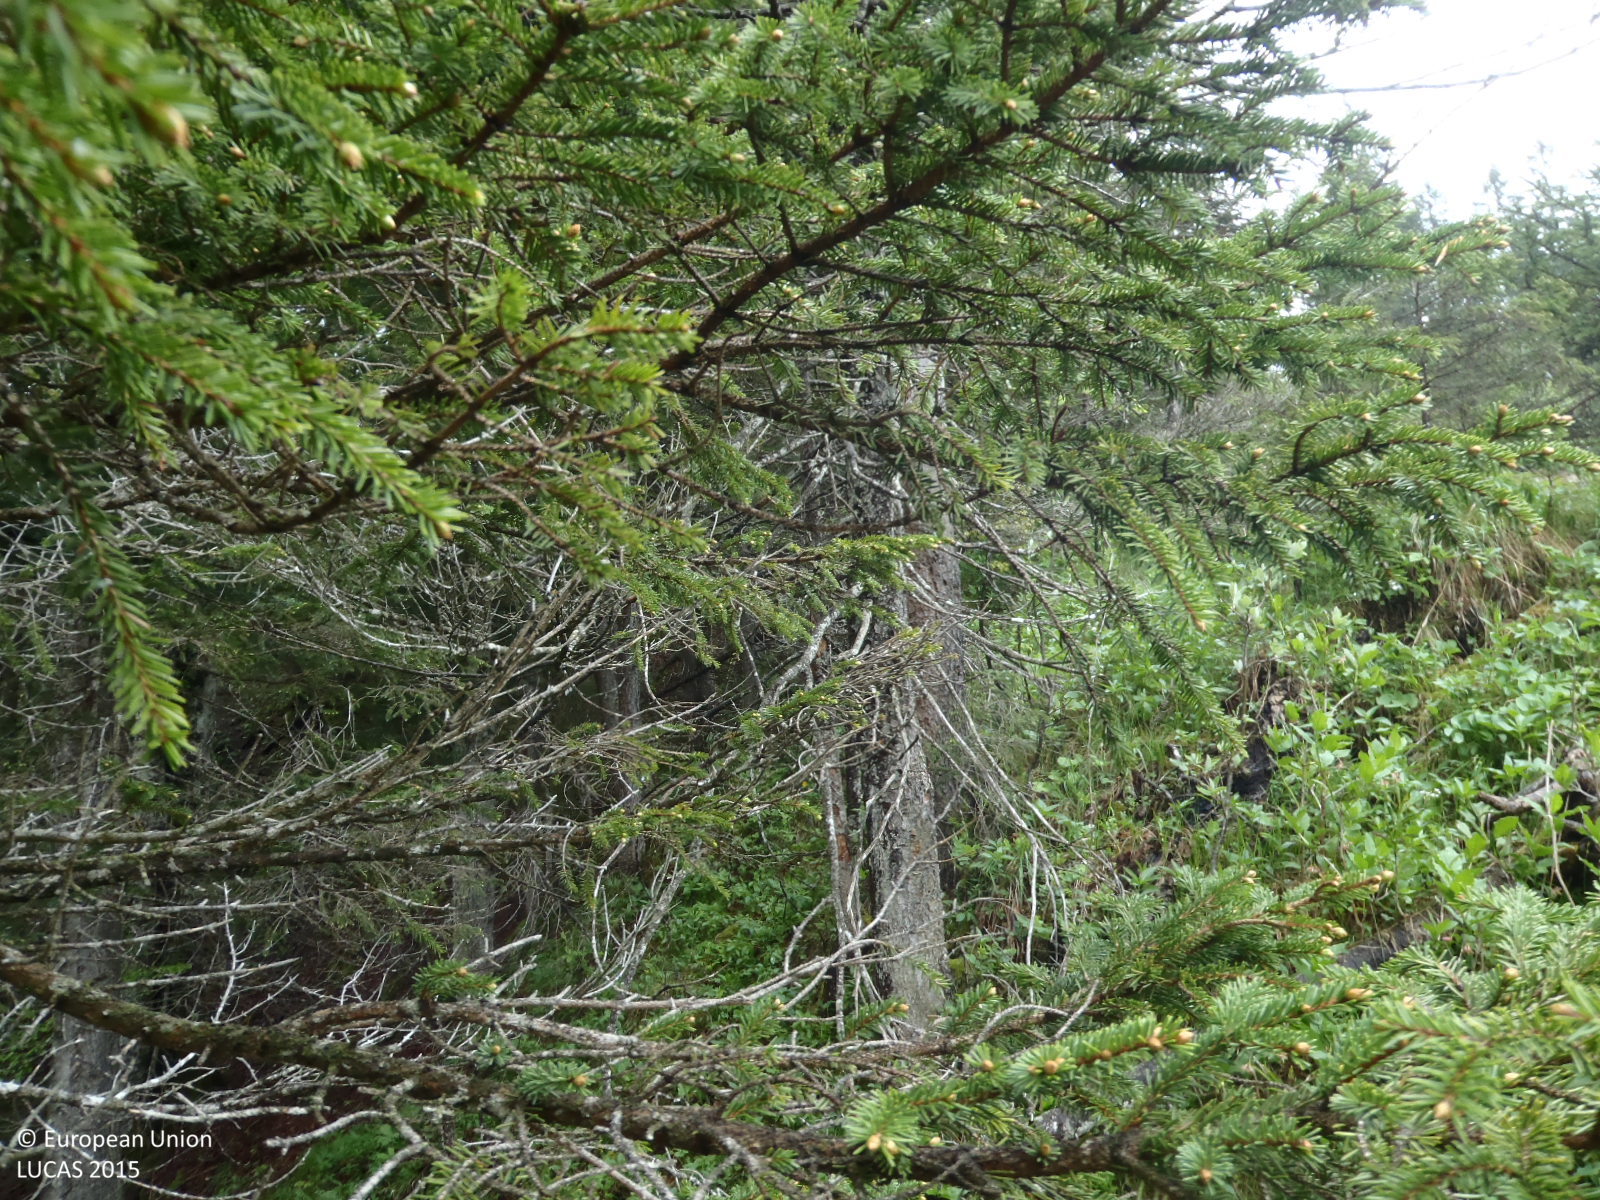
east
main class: Grassland
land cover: Grassland with sparse tree/shrub cover
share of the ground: > 75 %
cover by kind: herbaceous plants 55 %, unconsolidated bare surface 35 %, coniferous forest trees 5 %, shrubs 5 %
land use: Semi-natural and natural areas not in use
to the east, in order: Grassland with sparse tree/shrub cover; Spruce dominated mixed woodland; Grassland with sparse tree/shrub cover; Spruce dominated coniferous woodland; Grassland with sparse tree/shrub cover
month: May
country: AT
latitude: 47.4382
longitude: 11.5766
